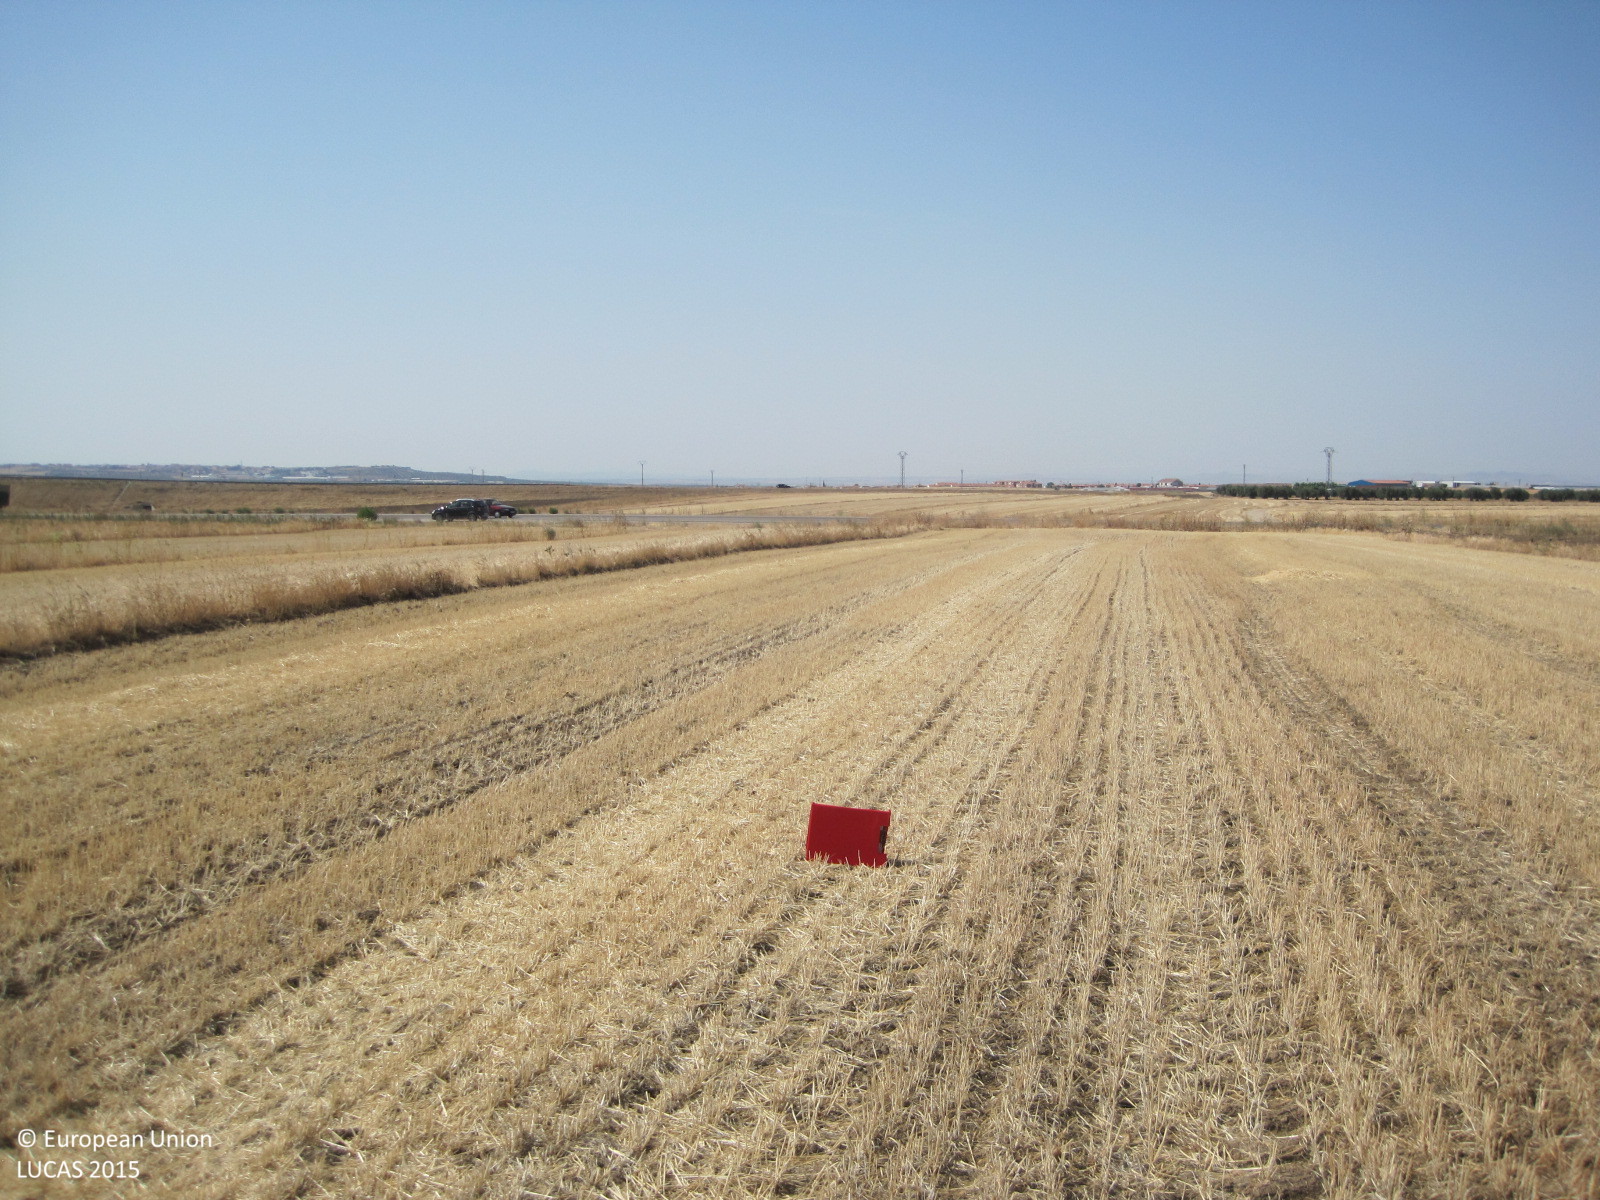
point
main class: Cropland
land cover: Barley
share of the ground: < 10 %
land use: Agriculture (excluding fallow land and kitchen gardens)
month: July
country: ES
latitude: 40.0699
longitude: -3.8353
